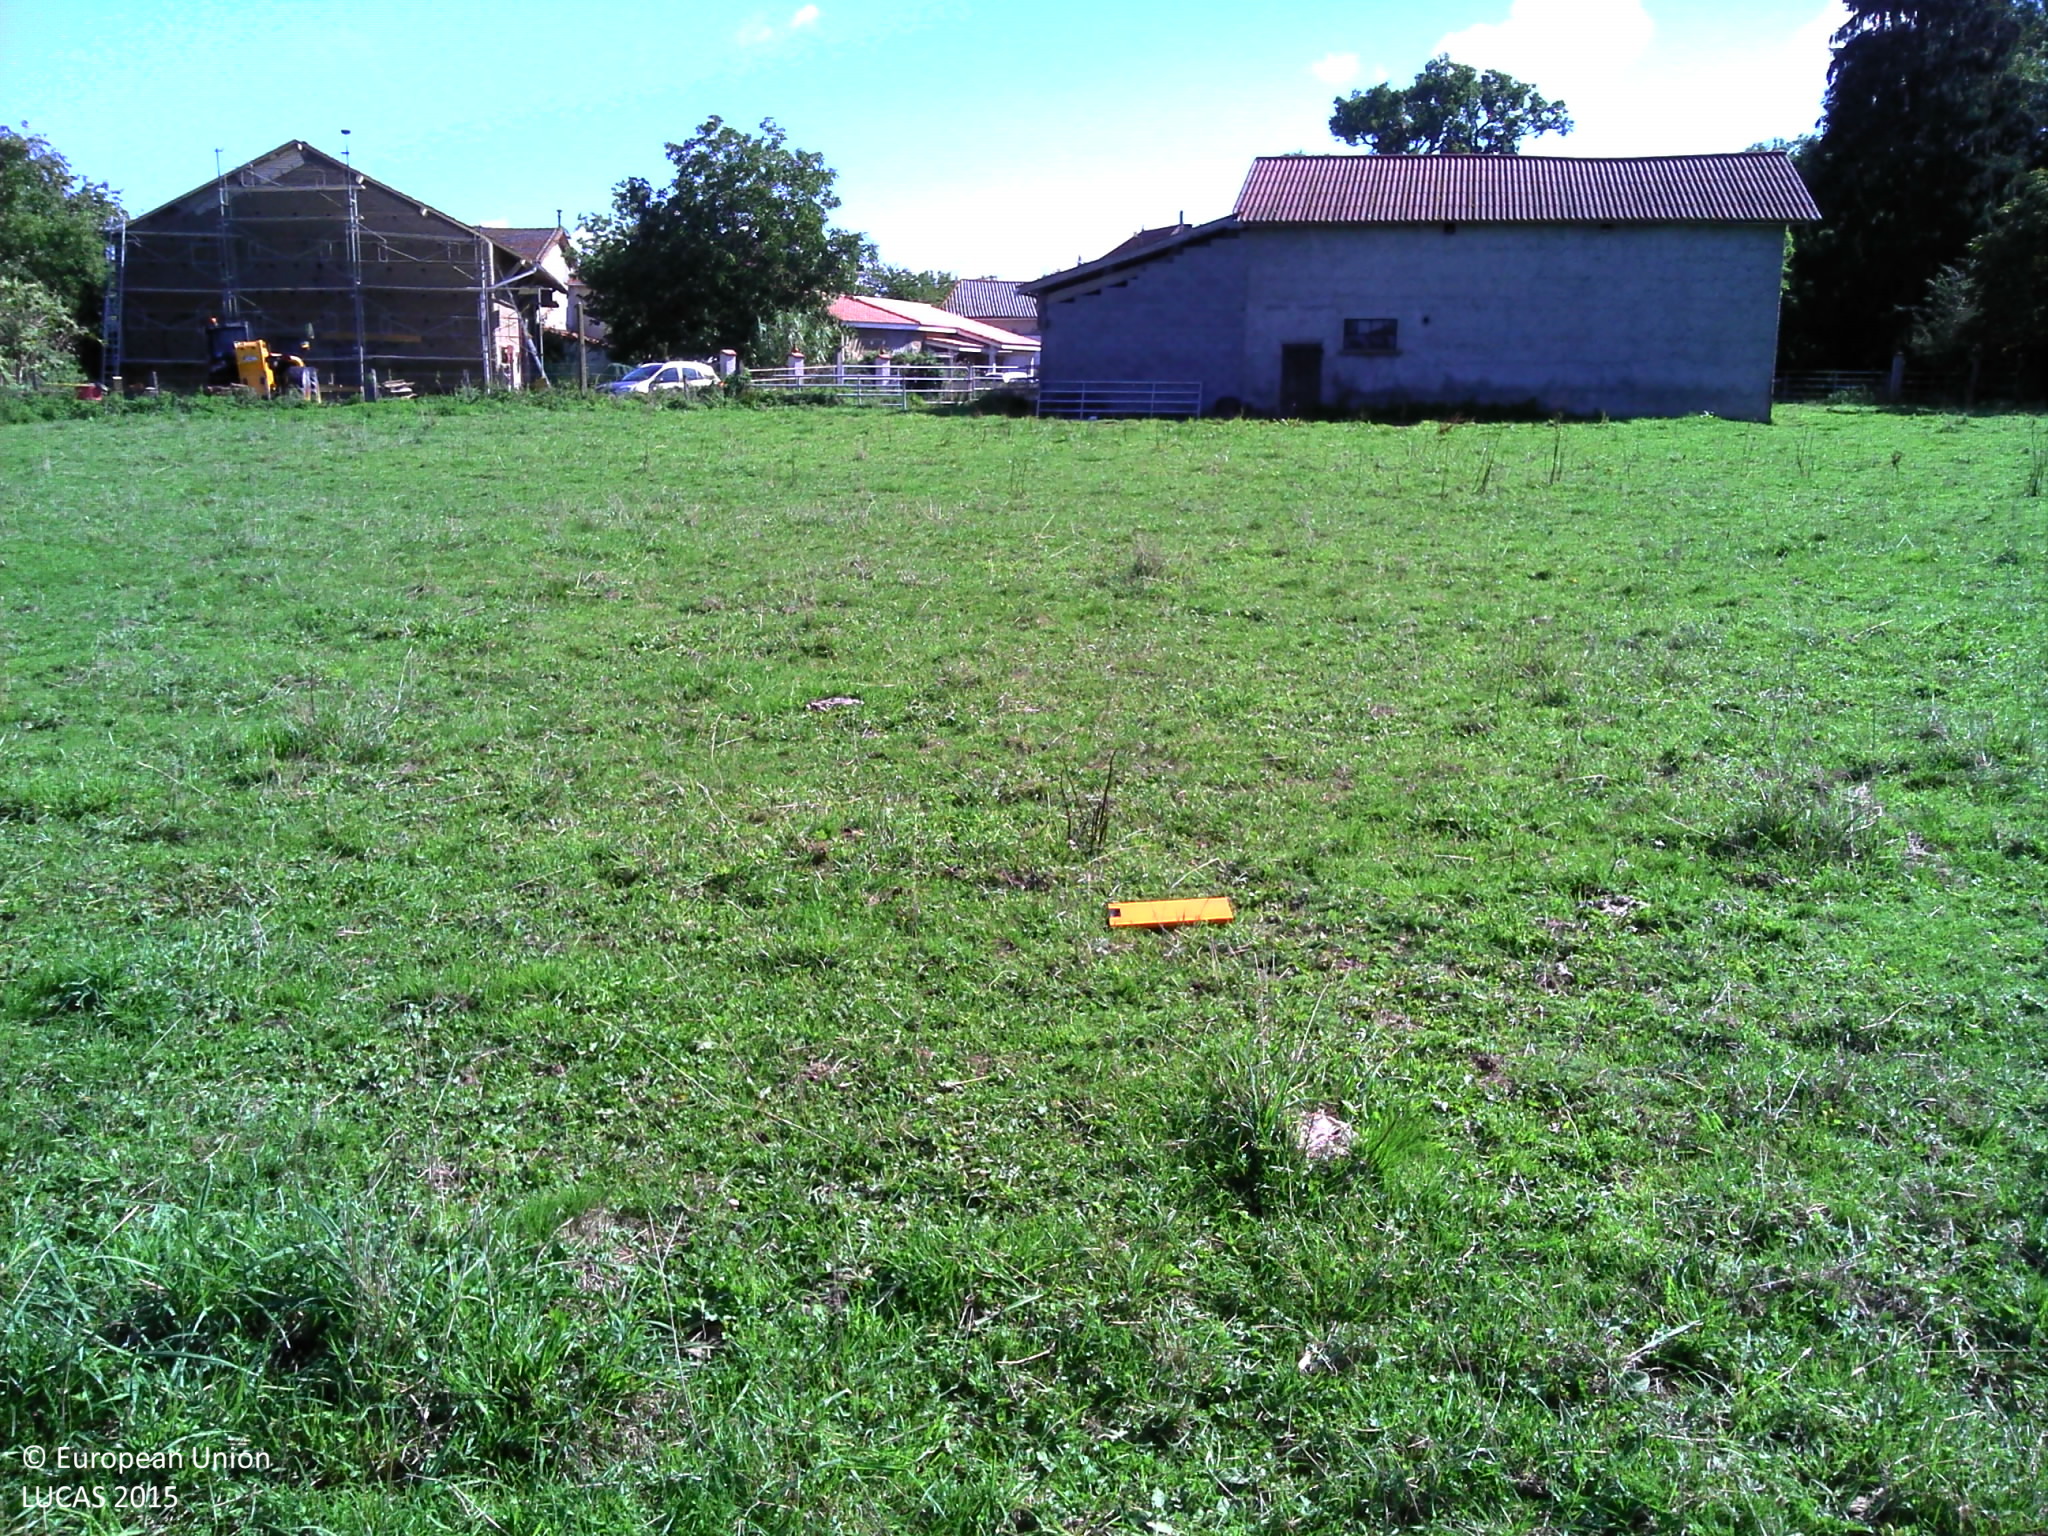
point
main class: Grassland
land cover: Grassland without tree/shrub cover
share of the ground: > 75 %
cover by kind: herbaceous plants 100 %
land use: Agriculture (excluding fallow land and kitchen gardens)
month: September
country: FR
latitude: 45.8757
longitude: 3.3911
